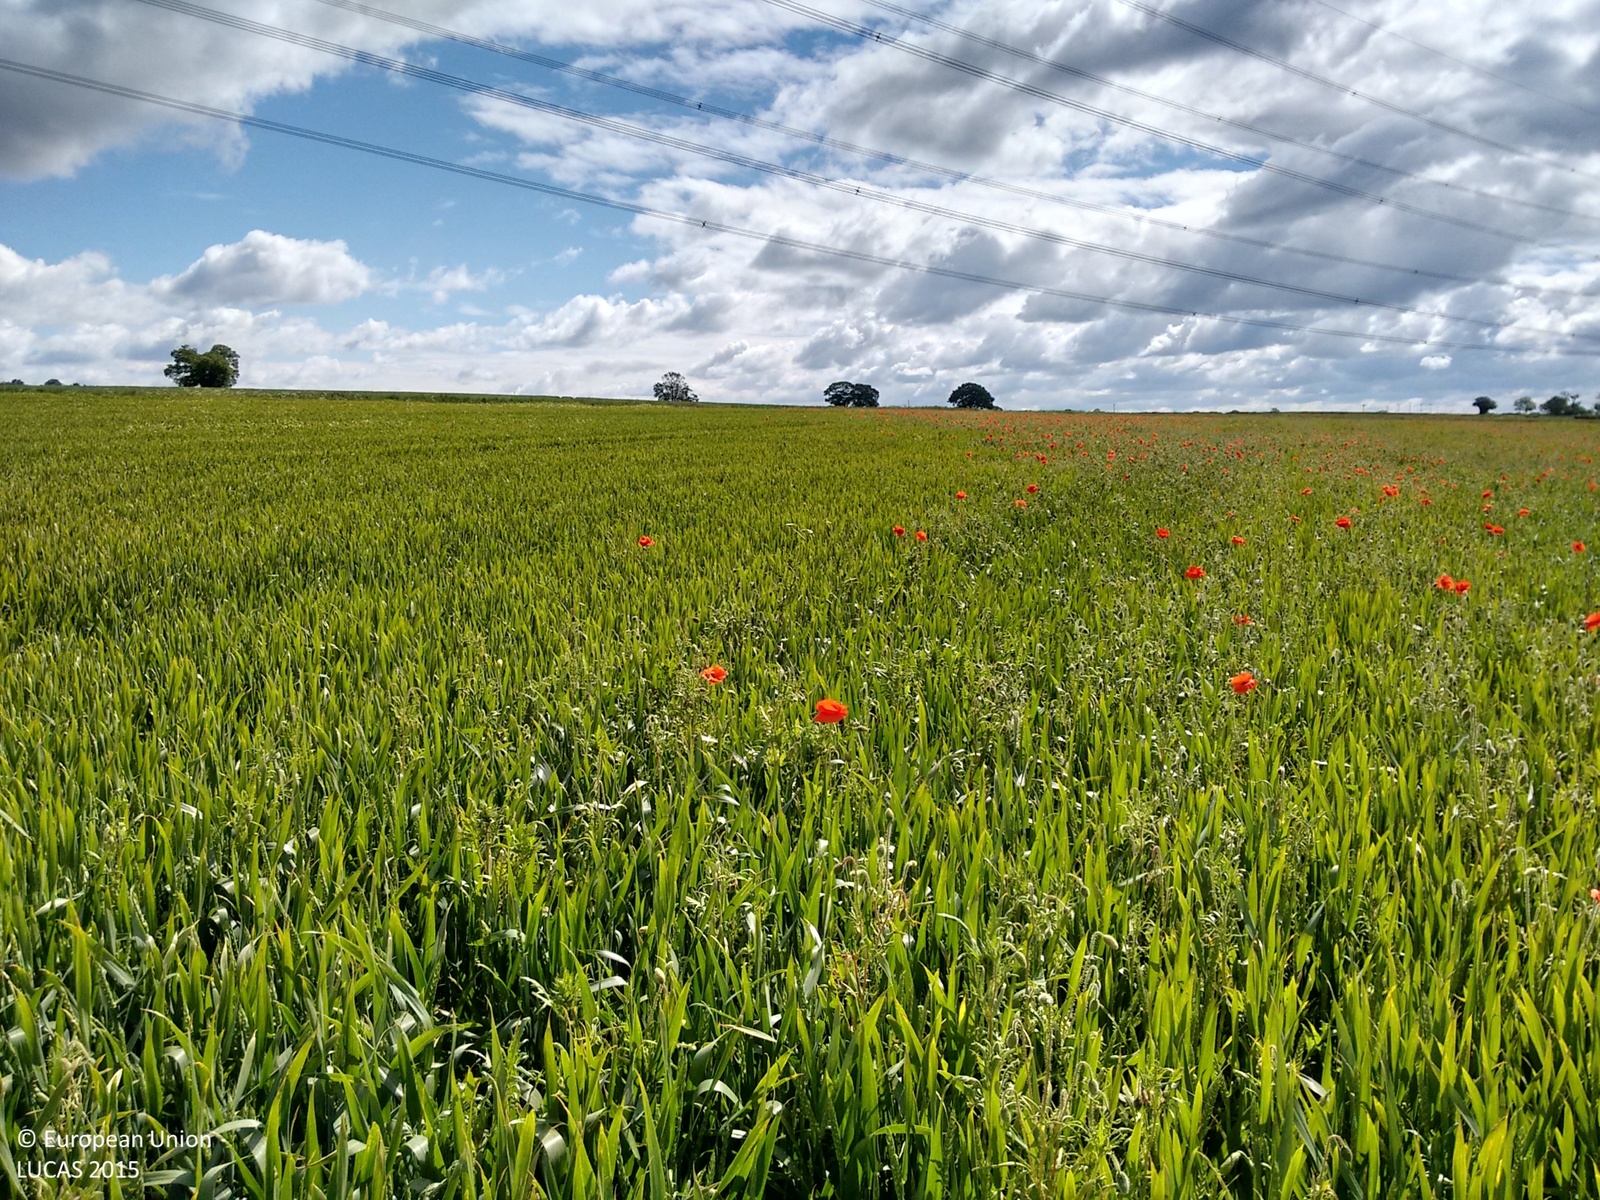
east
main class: Cropland
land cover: Common wheat
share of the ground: > 75 %
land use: Agriculture (excluding fallow land and kitchen gardens)
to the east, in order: Common wheat; Electric lines; Spontaneously vegetated surfaces; Common wheat
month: June
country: GB
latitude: 54.1184
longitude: -1.1671
